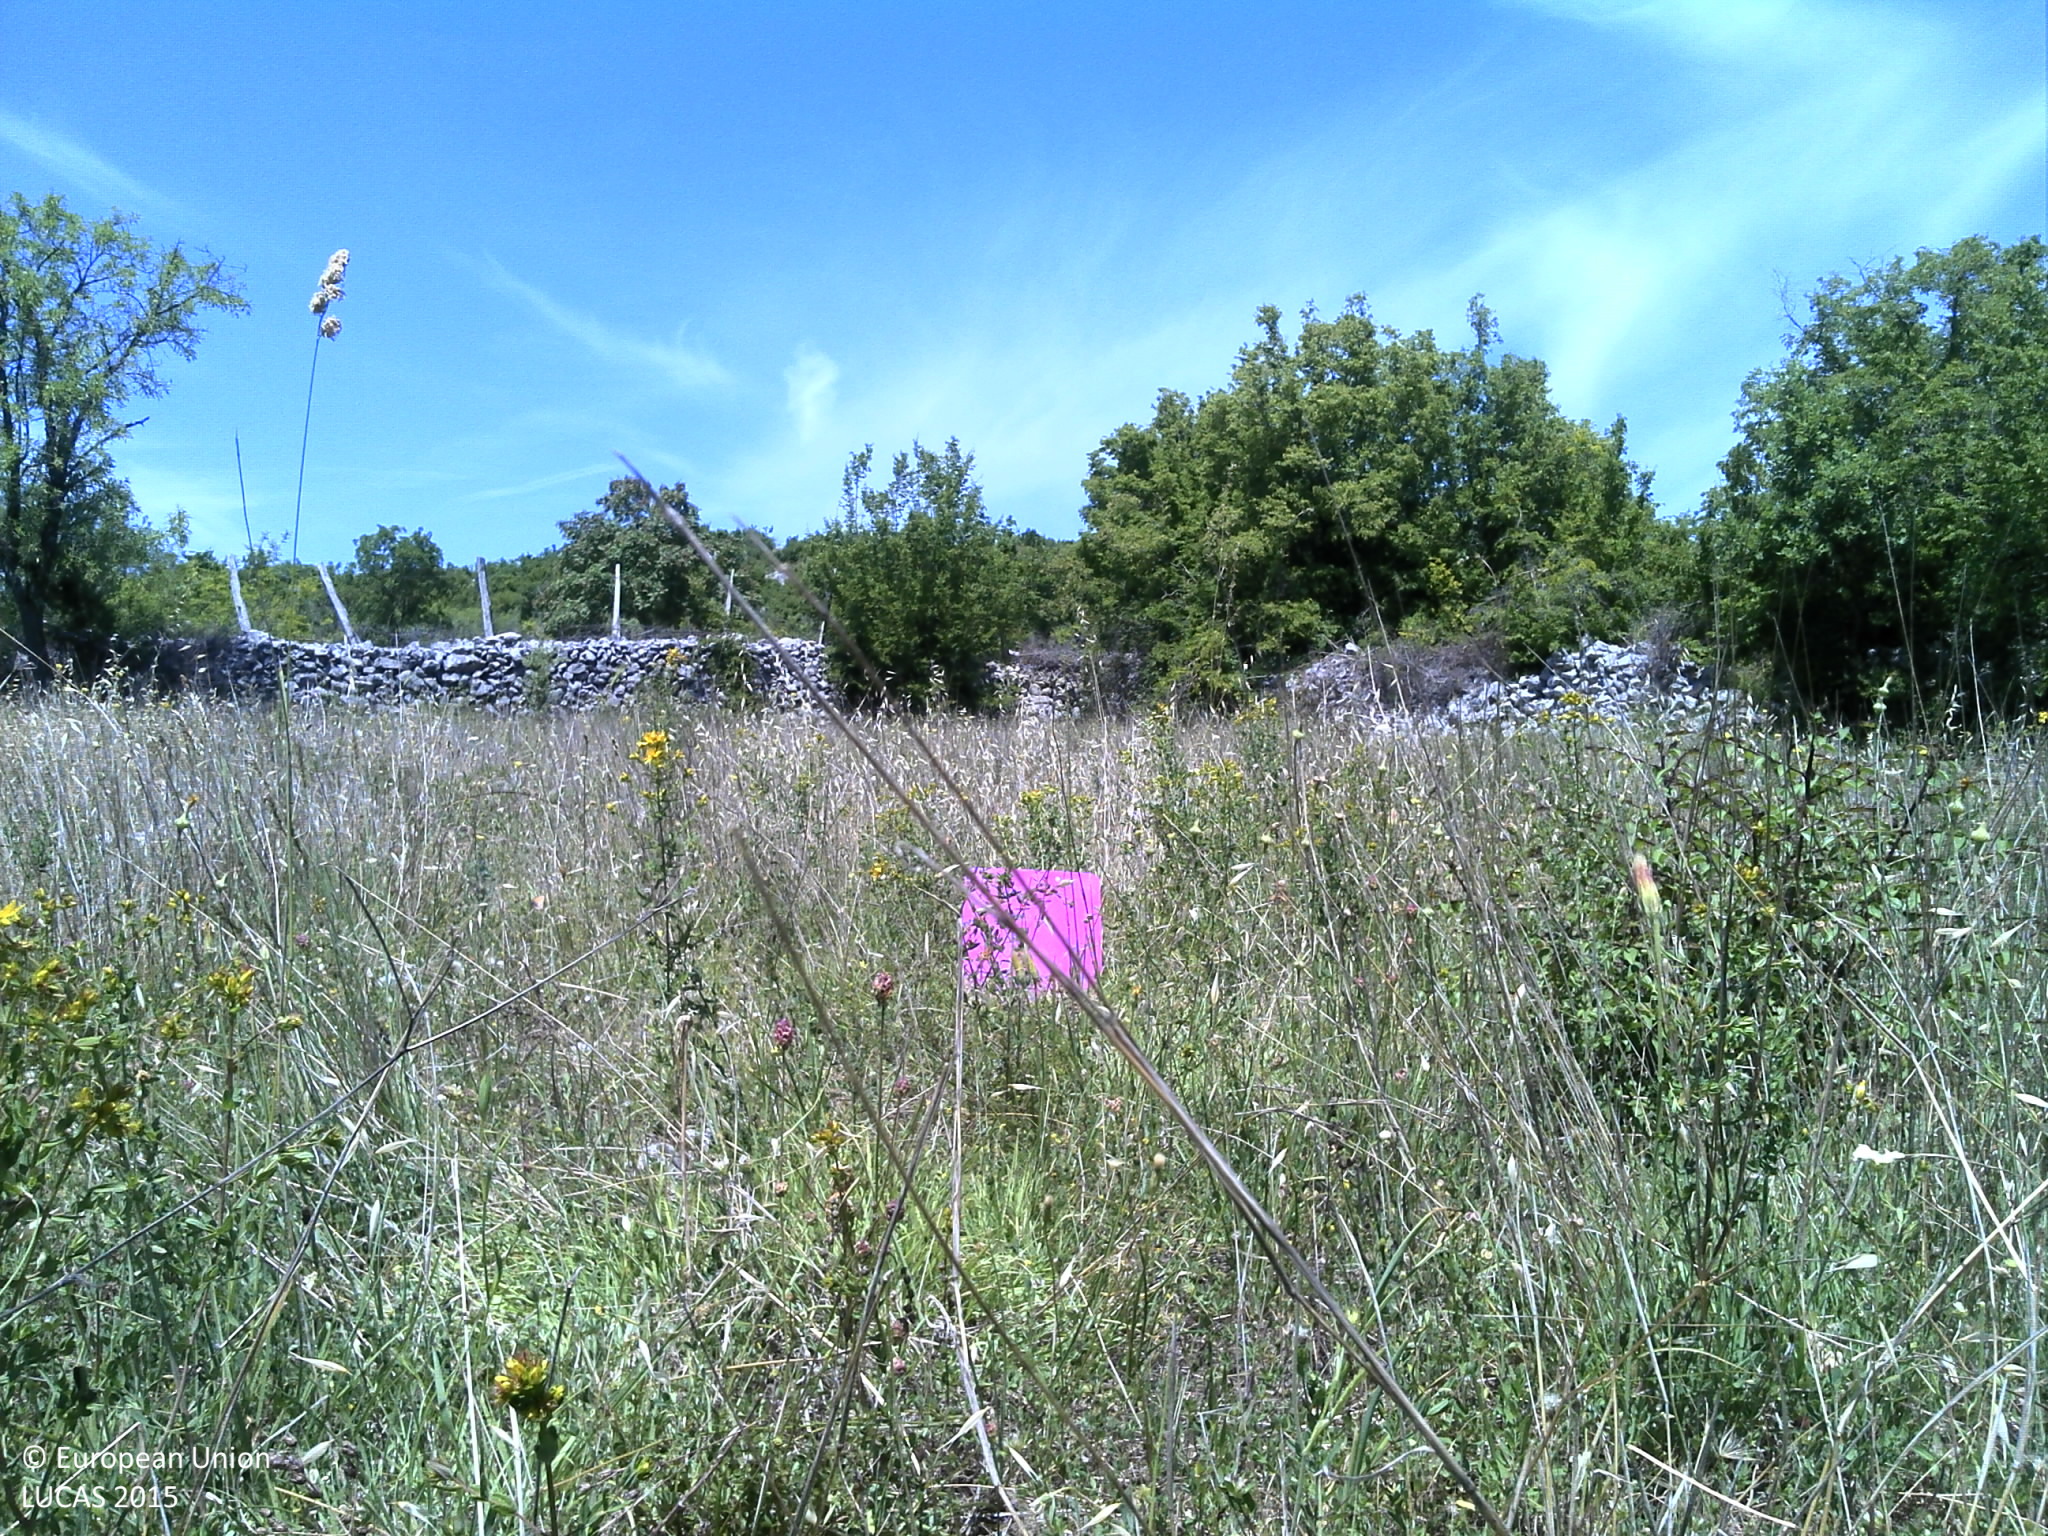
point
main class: Grassland
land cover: Grassland with sparse tree/shrub cover
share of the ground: > 75 %
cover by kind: herbaceous plants 85 %, coniferous forest trees 5 %, shrubs 5 %, consolidated bare surface 5 %
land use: Abandoned areas
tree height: < 5 m
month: June
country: HR
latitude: 43.7303
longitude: 16.2112
